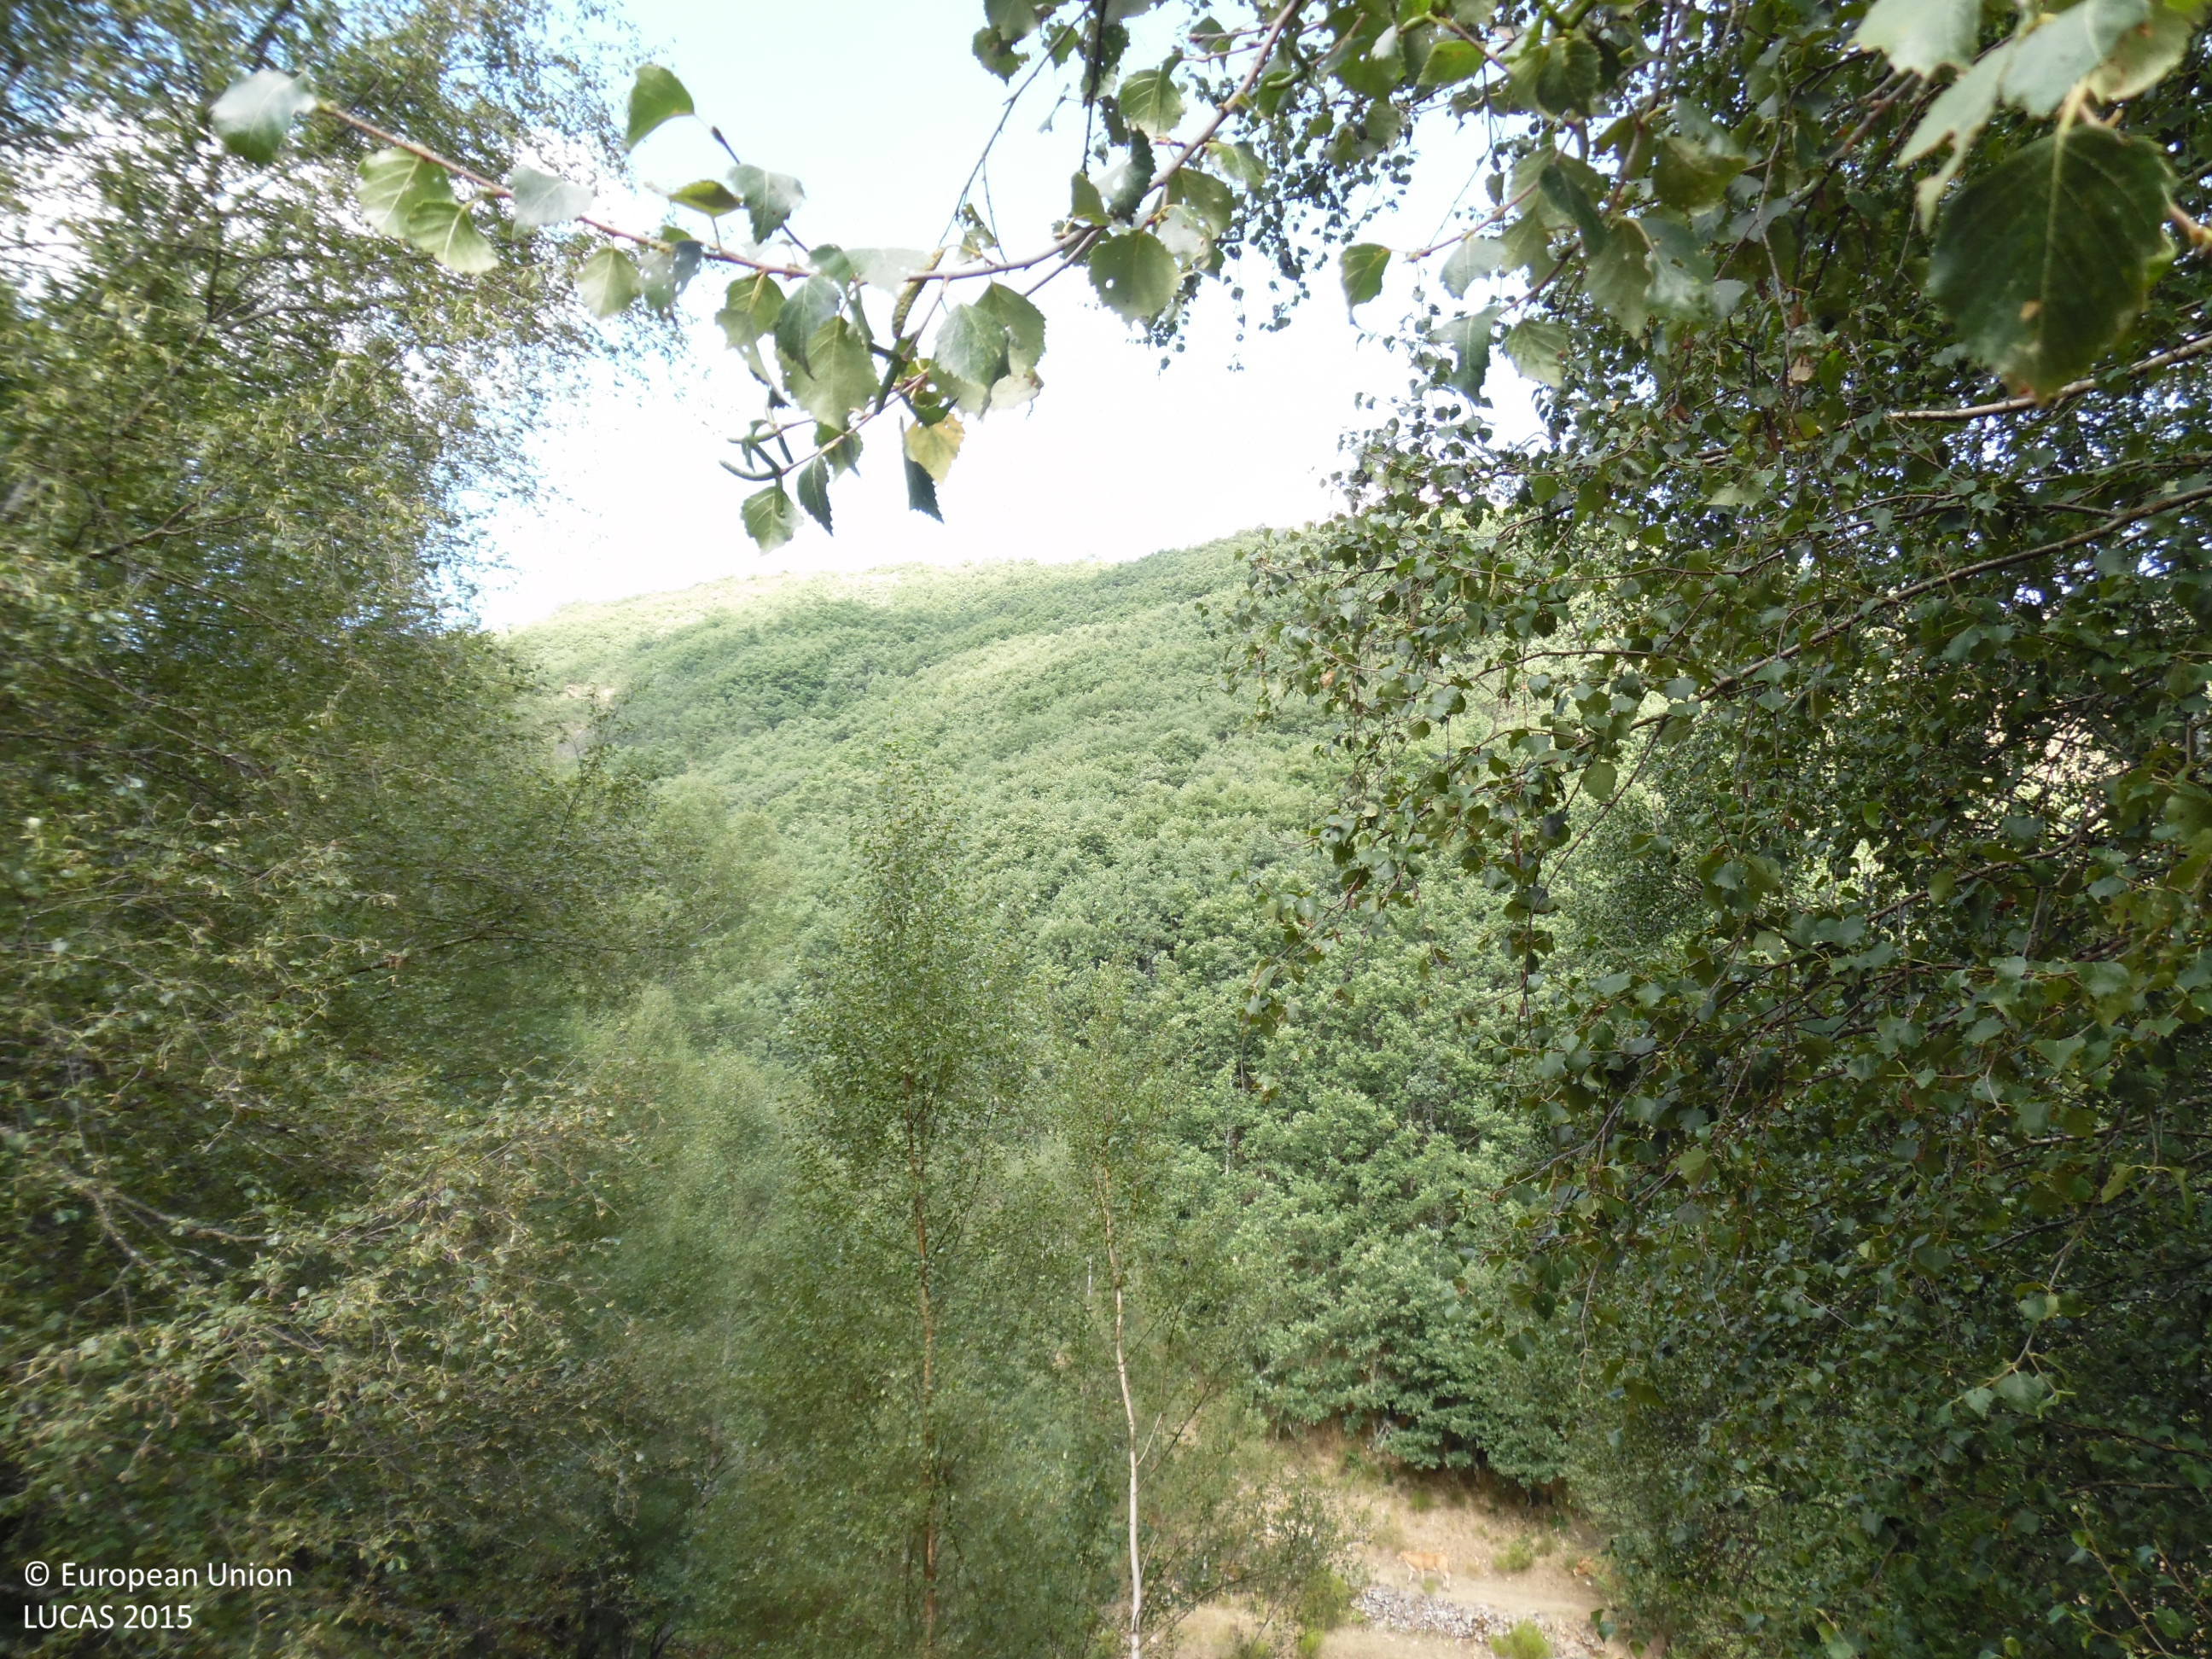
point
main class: Woodland
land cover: Broadleaved woodland
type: thermophilous deciduous forest
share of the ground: > 75 %
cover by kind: broadleaved forest trees 100 %
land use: Forestry
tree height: > 5 m
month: August
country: ES
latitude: 42.8148
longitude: -6.1711
